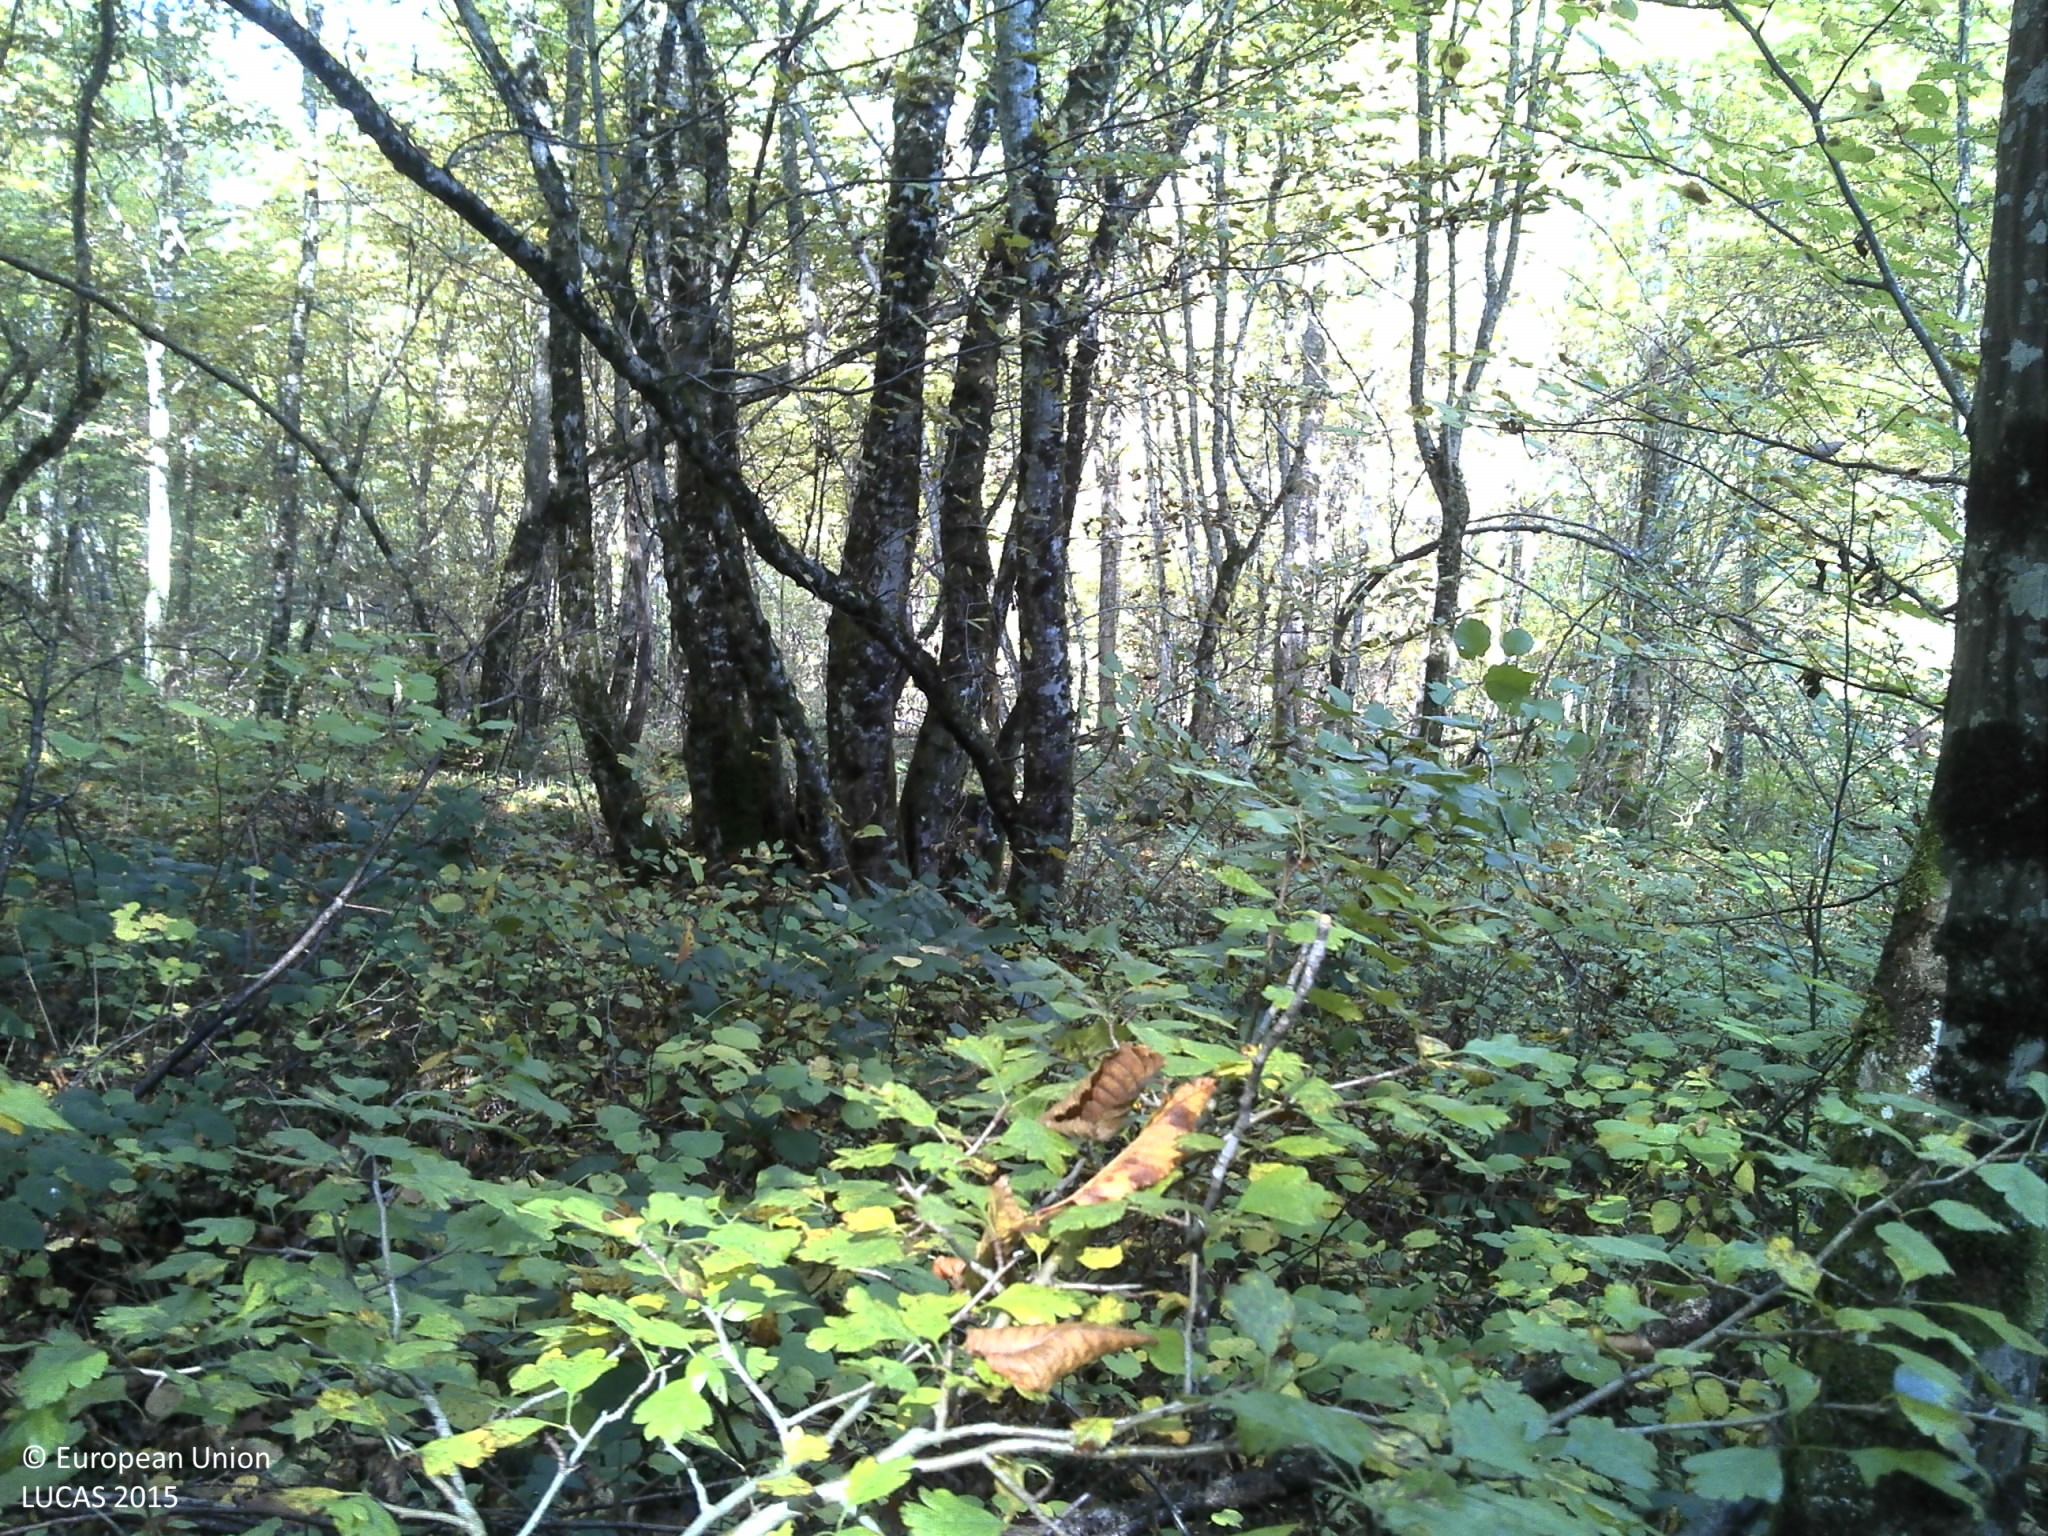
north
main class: Woodland
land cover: Broadleaved woodland
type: mesophytic deciduous forest
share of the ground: > 75 %
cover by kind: broadleaved forest trees 90 %, lichens and mosses 5 %, unconsolidated bare surface 5 %
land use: Forestry
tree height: > 5 m
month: October
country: FR
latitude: 45.8916
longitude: 5.4030
